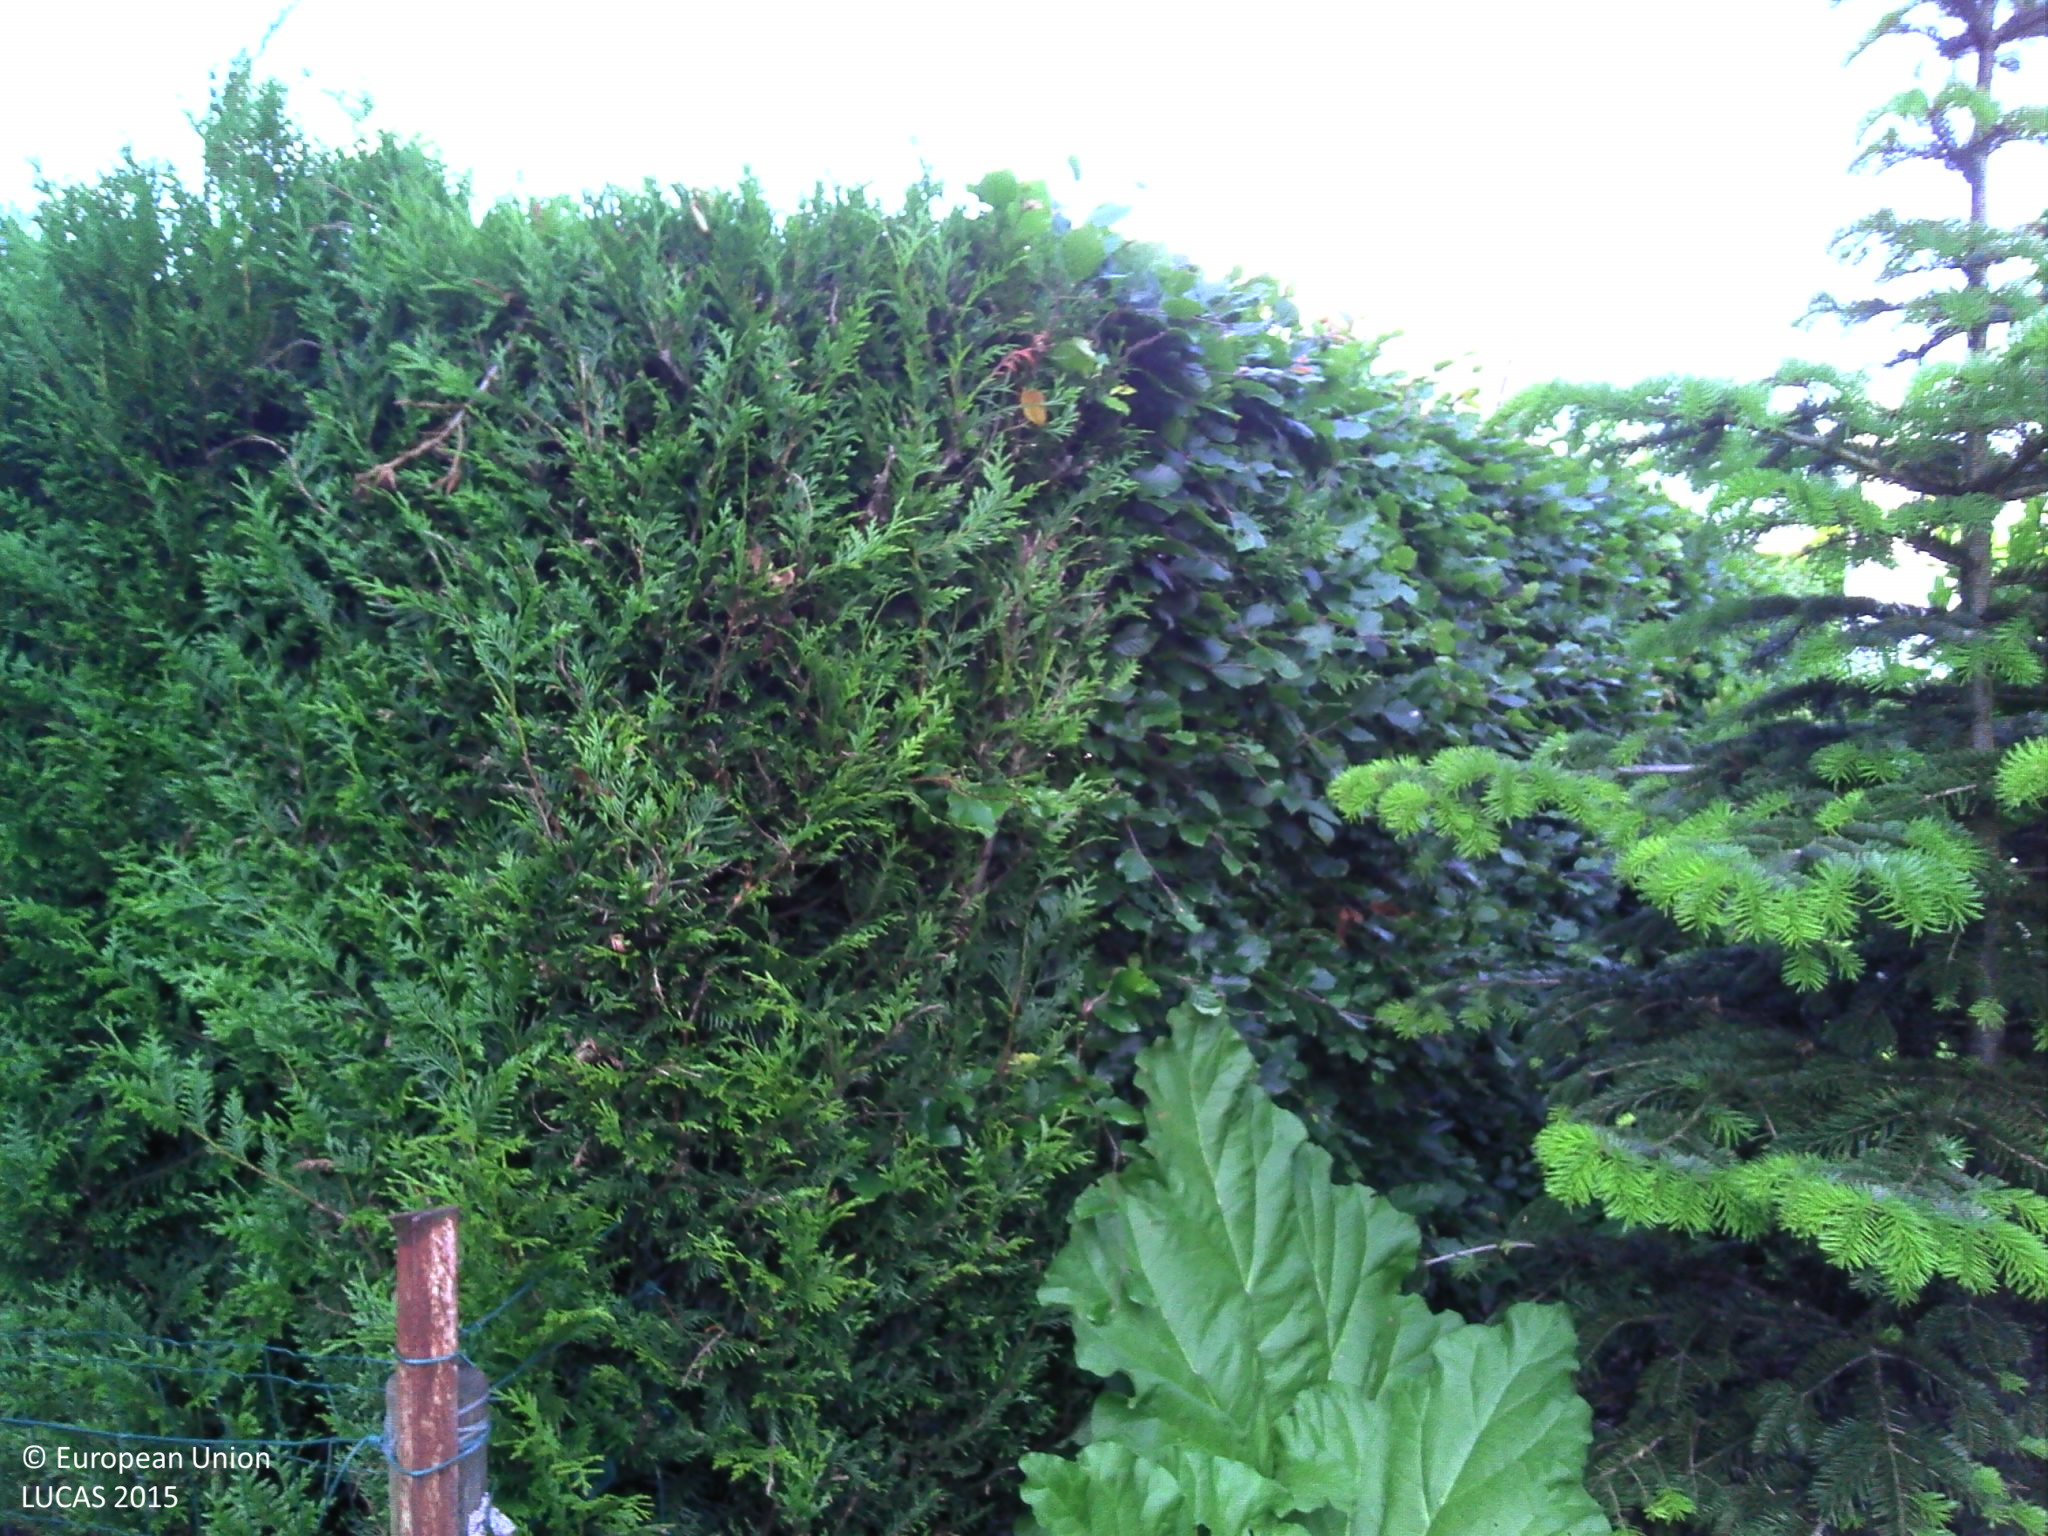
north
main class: Grassland
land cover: Grassland without tree/shrub cover
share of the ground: > 75 %
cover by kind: herbaceous plants 100 %
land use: Residential
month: June
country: BE
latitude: 51.0116
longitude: 3.8790
